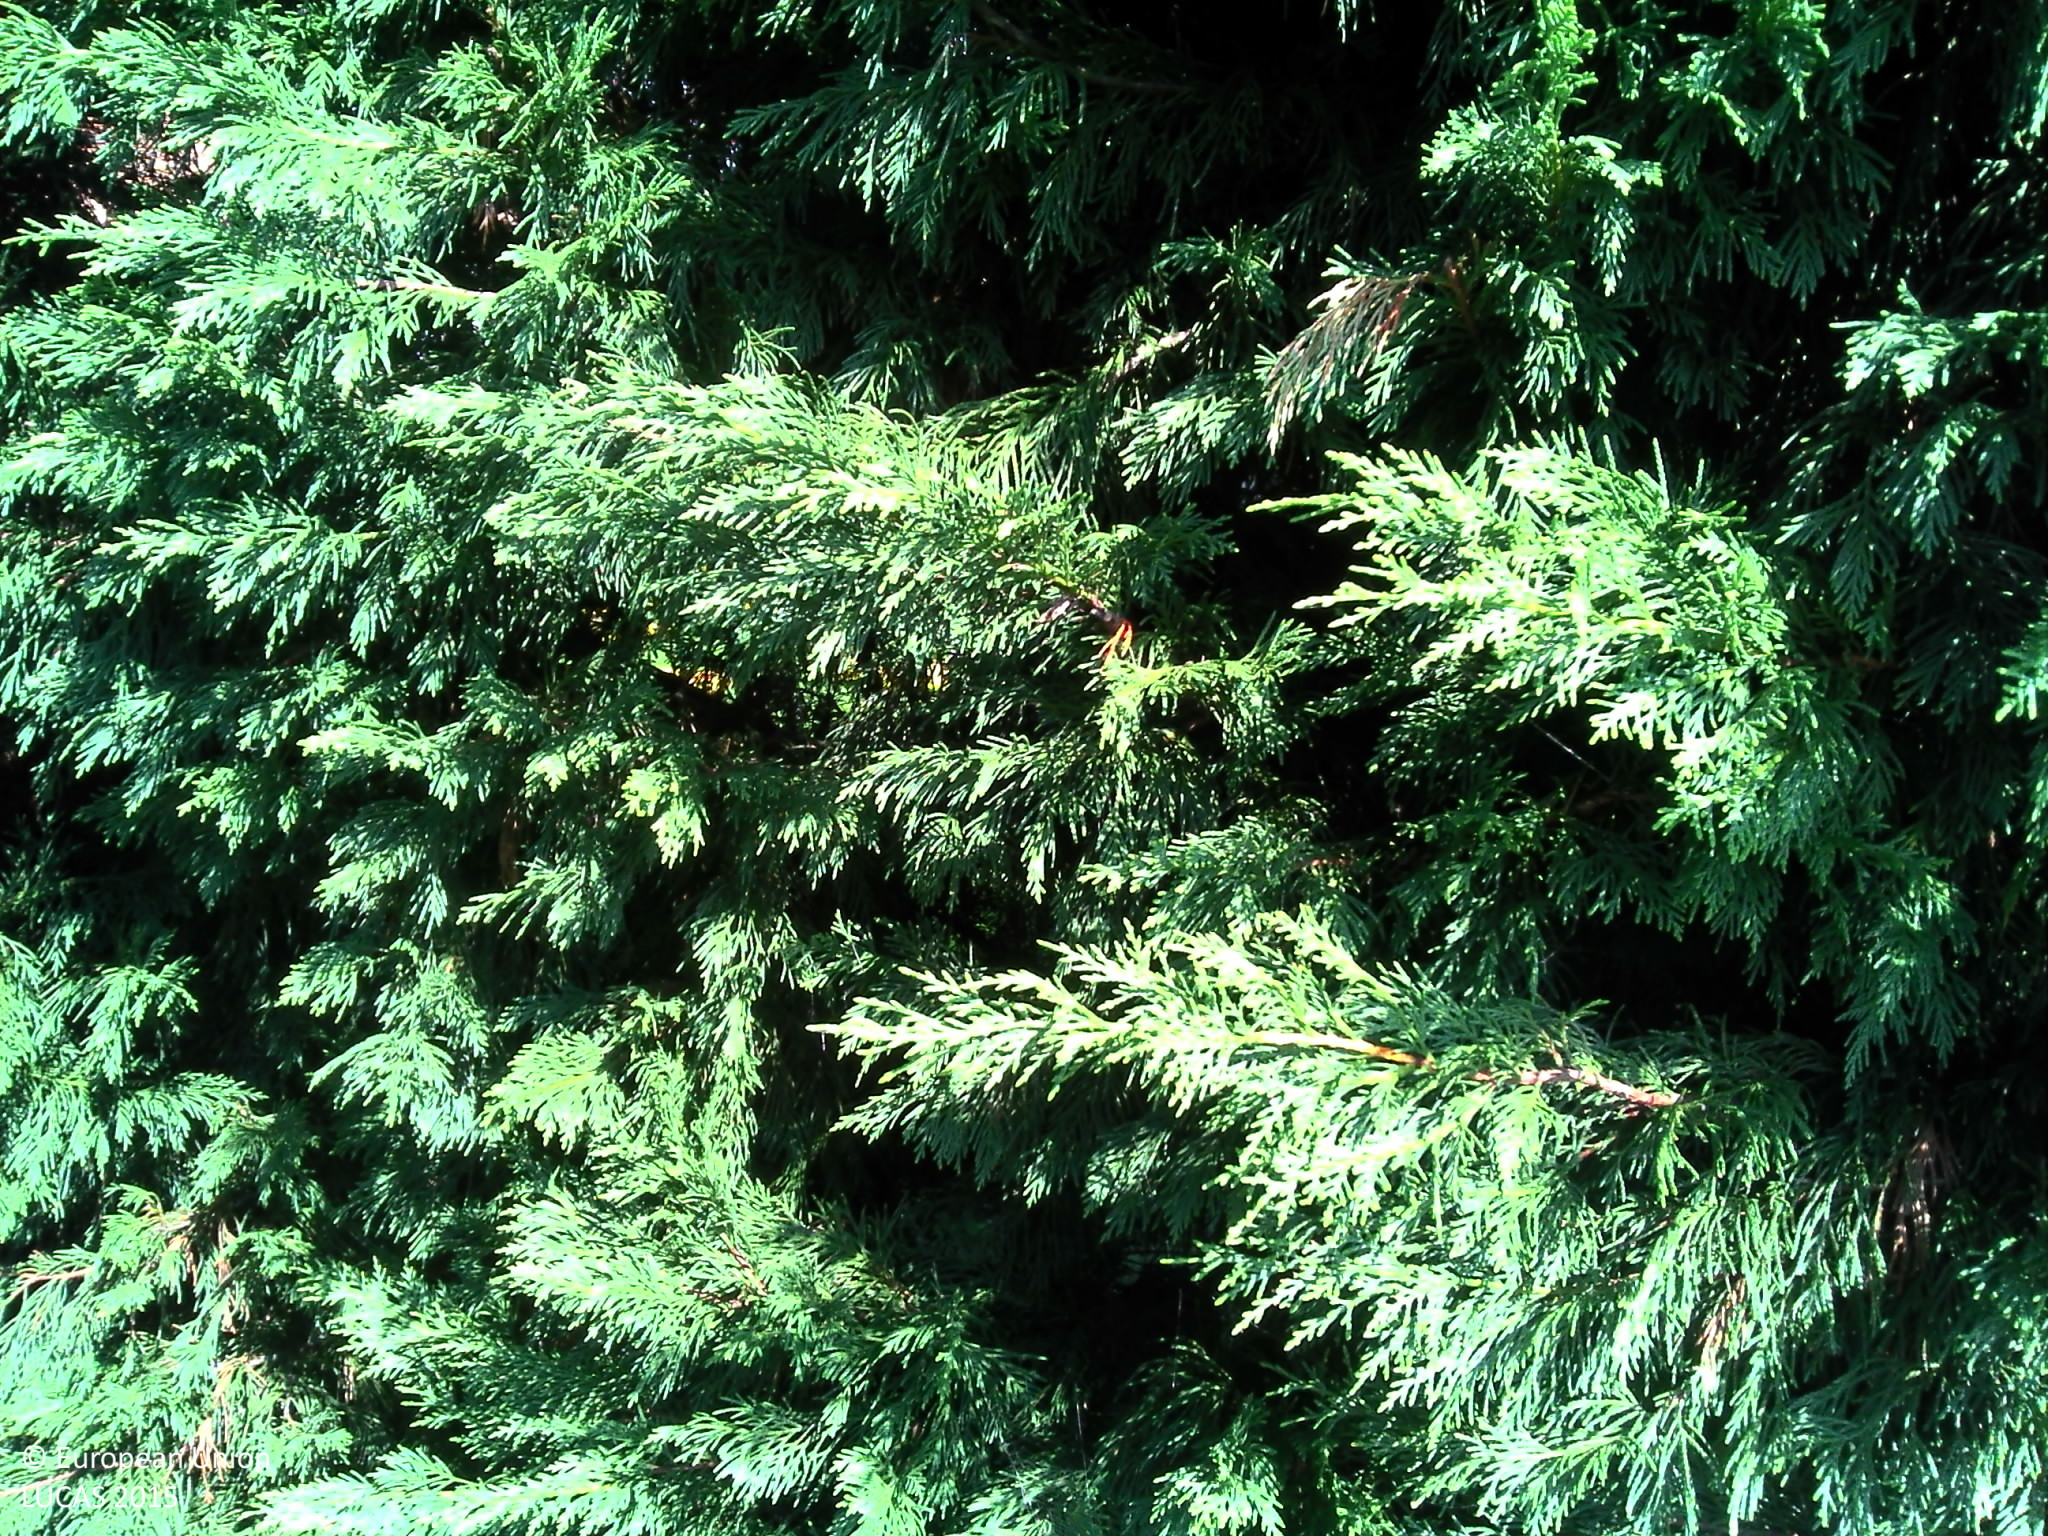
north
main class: Grassland
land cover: Grassland without tree/shrub cover
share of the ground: > 75 %
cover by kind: herbaceous plants 100 %
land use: Residential
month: October
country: FR
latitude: 46.4445
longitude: -1.2684
